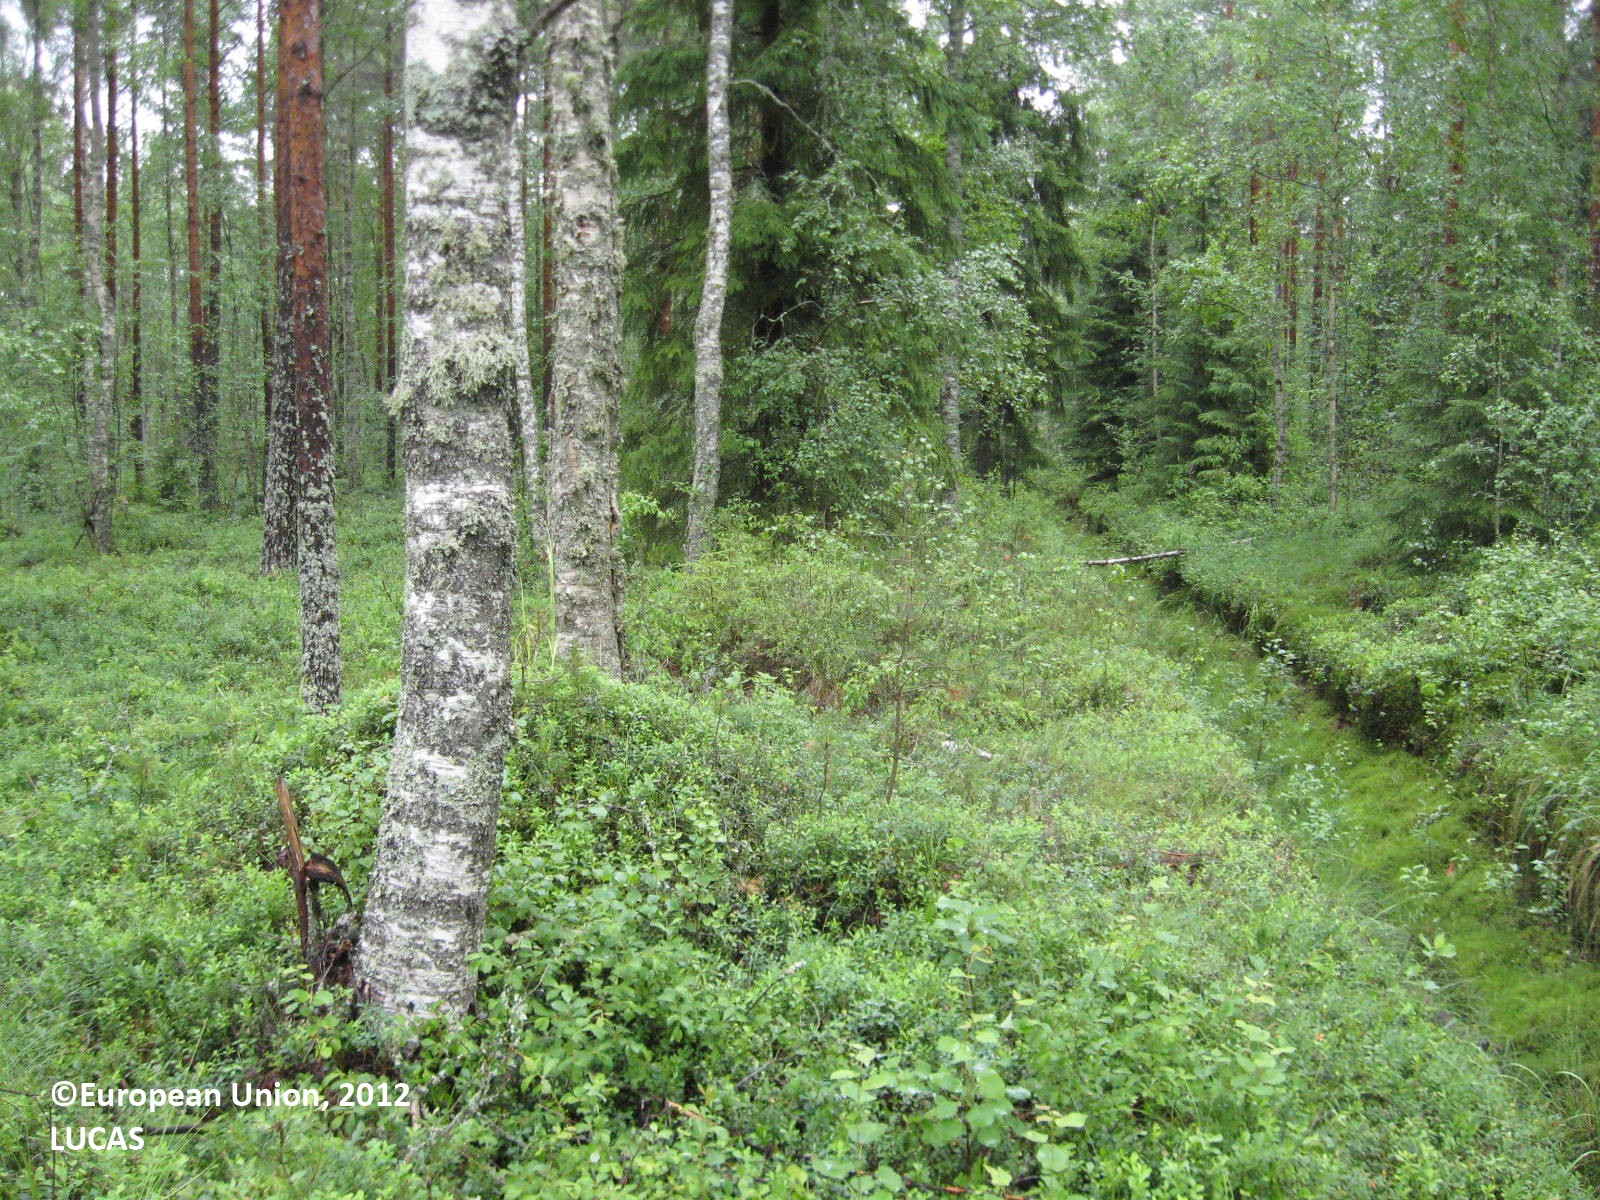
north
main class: Woodland
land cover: Pine dominated coniferous woodland
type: boreal forest
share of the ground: > 75 %
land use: Forestry
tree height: > 5 m
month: July
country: FI
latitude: 62.4629
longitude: 22.4052
